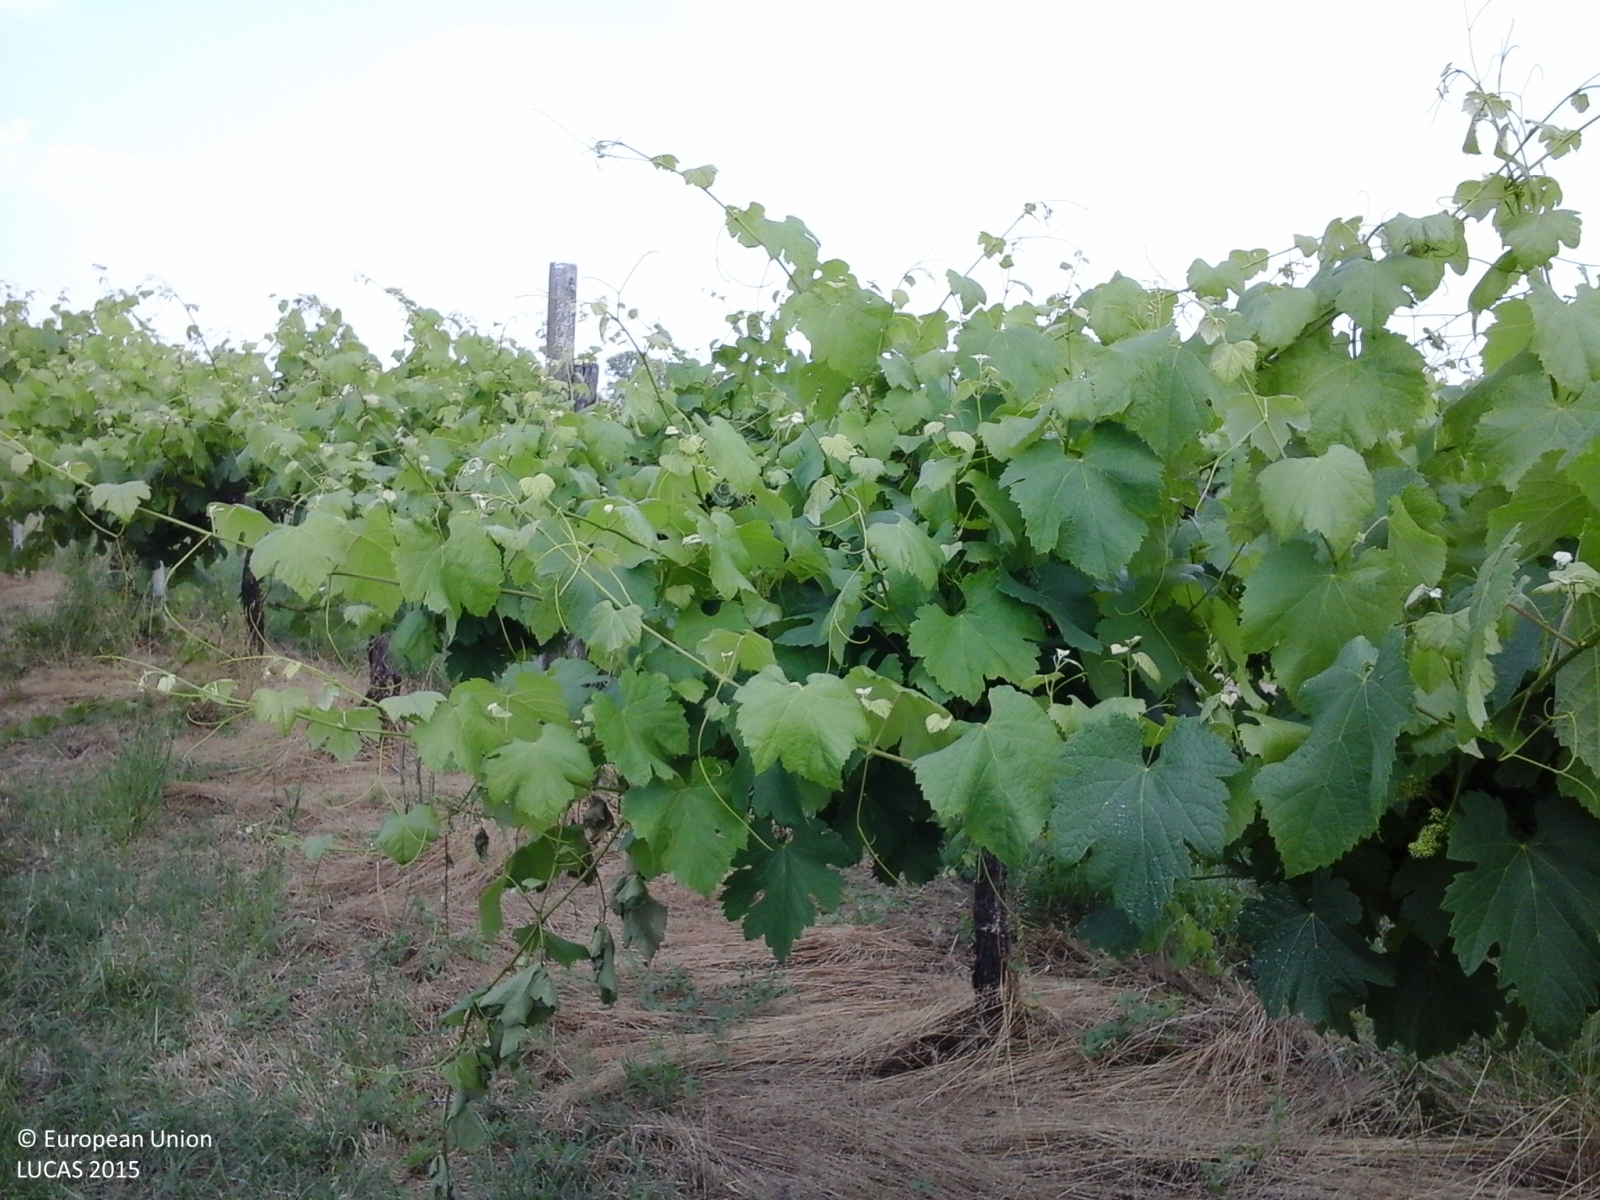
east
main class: Cropland
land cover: Vineyards
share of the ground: 25 - 50 %
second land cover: Grassland without tree/shrub cover
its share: 50 - 75 %
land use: Agriculture (excluding fallow land and kitchen gardens)
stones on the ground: < 10 %
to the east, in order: Vineyards; Grassland without tree/shrub cover; Ditches and canals; Grassland without tree/shrub cover; Tracks; Grass margins; Maize; Ditches and canals; Maize; Ditches and canals; Maize; Ditches and canals; Maize; Ditches and canals; Maize
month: May
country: IT
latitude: 44.7630
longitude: 10.6934
